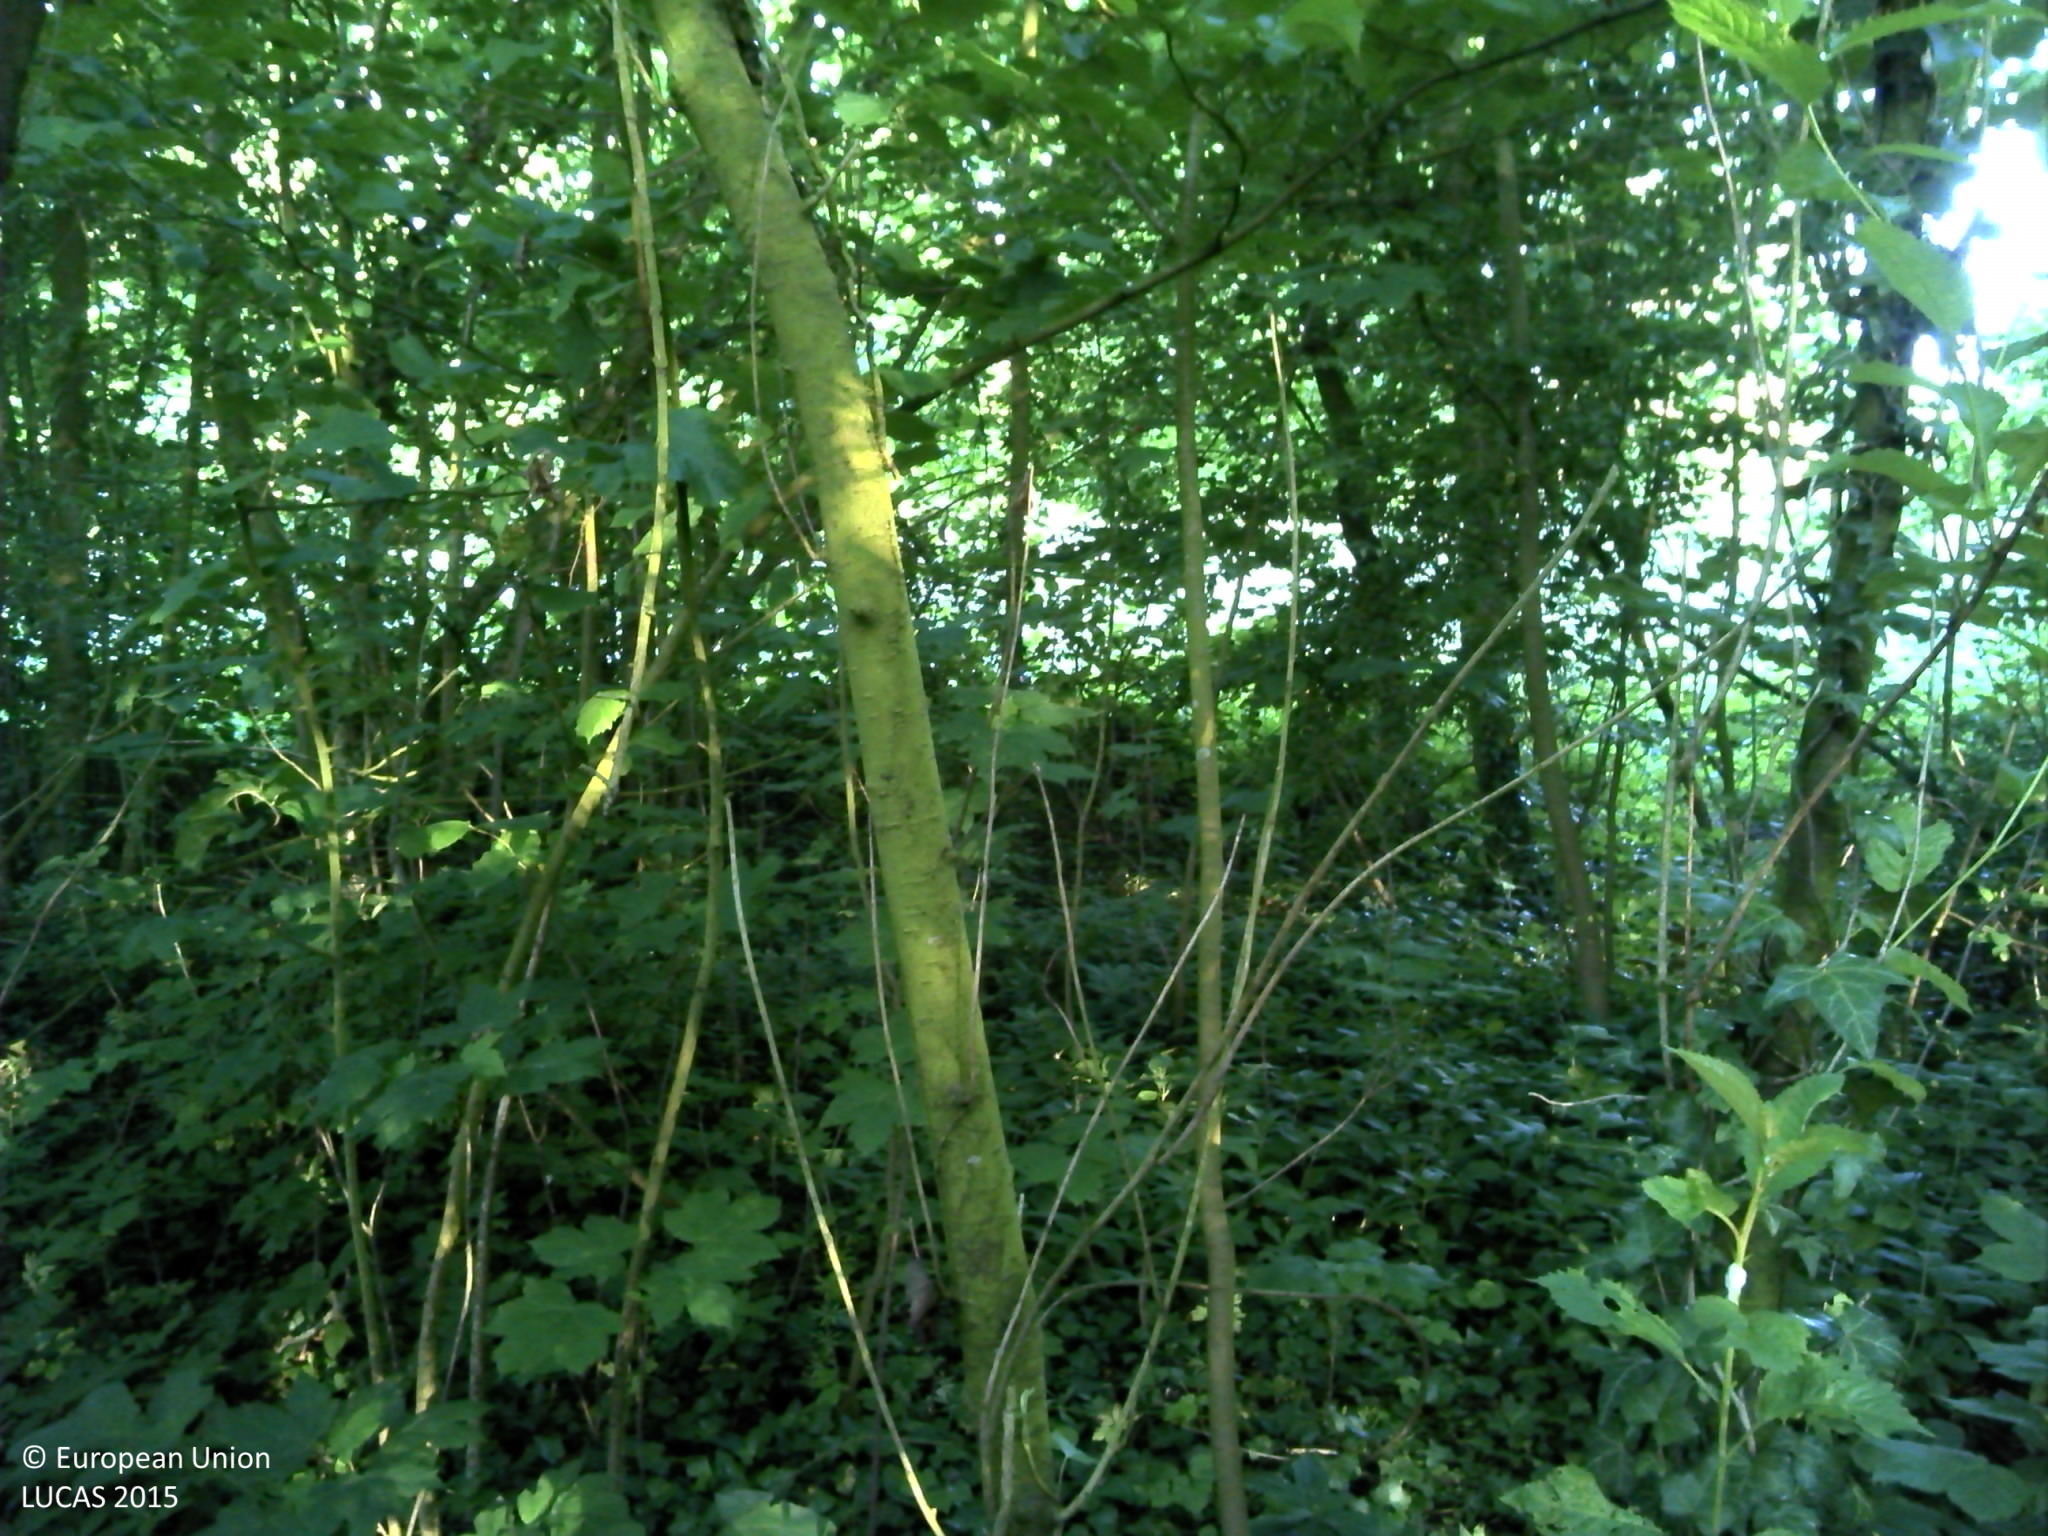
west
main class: Woodland
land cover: Broadleaved woodland
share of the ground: > 75 %
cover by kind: broadleaved forest trees 80 %, herbaceous plants 20 %
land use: Forestry
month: June
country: FR
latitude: 49.6746
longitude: 1.1235
